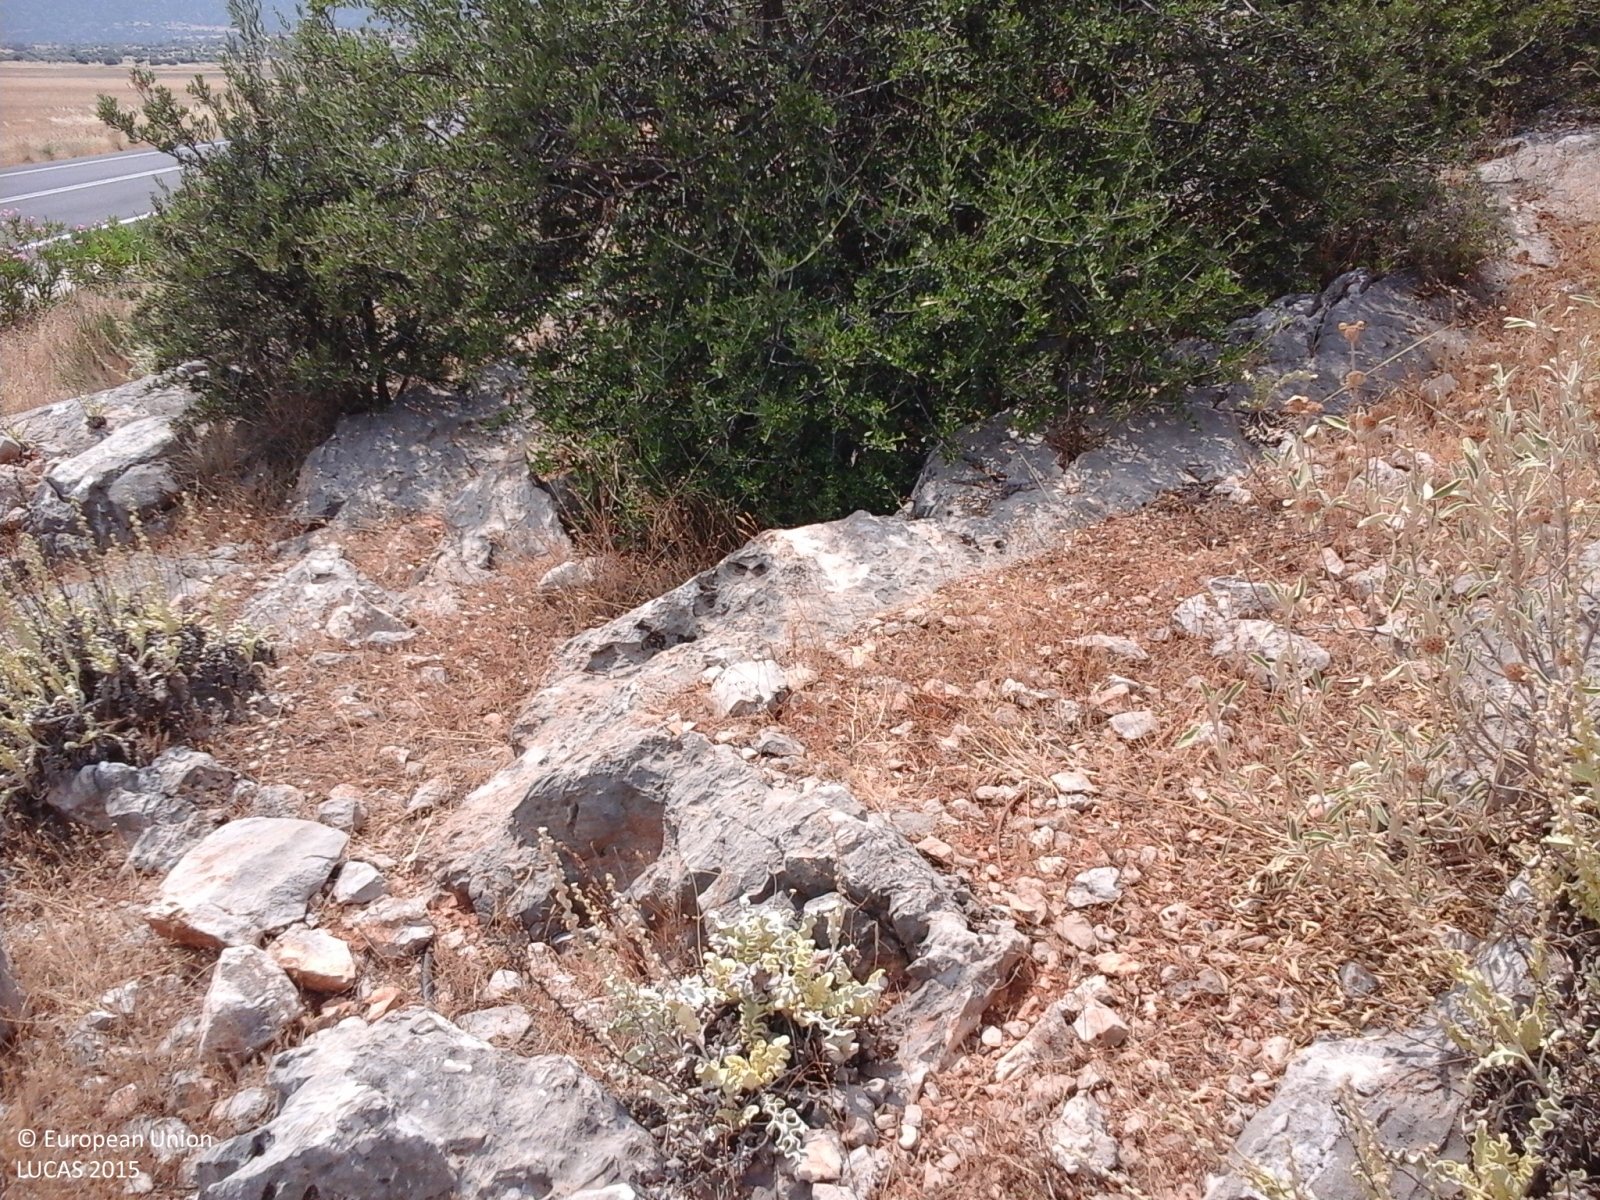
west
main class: Shrubland
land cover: Shrubland without tree cover
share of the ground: 50 - 75 %
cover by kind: shrubs 50 %, unconsolidated bare surface 30 %, herbaceous plants 10 %, consolidated bare surface 10 %
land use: Agriculture (excluding fallow land and kitchen gardens)
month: July
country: GR
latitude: 38.2519
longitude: 22.9465
